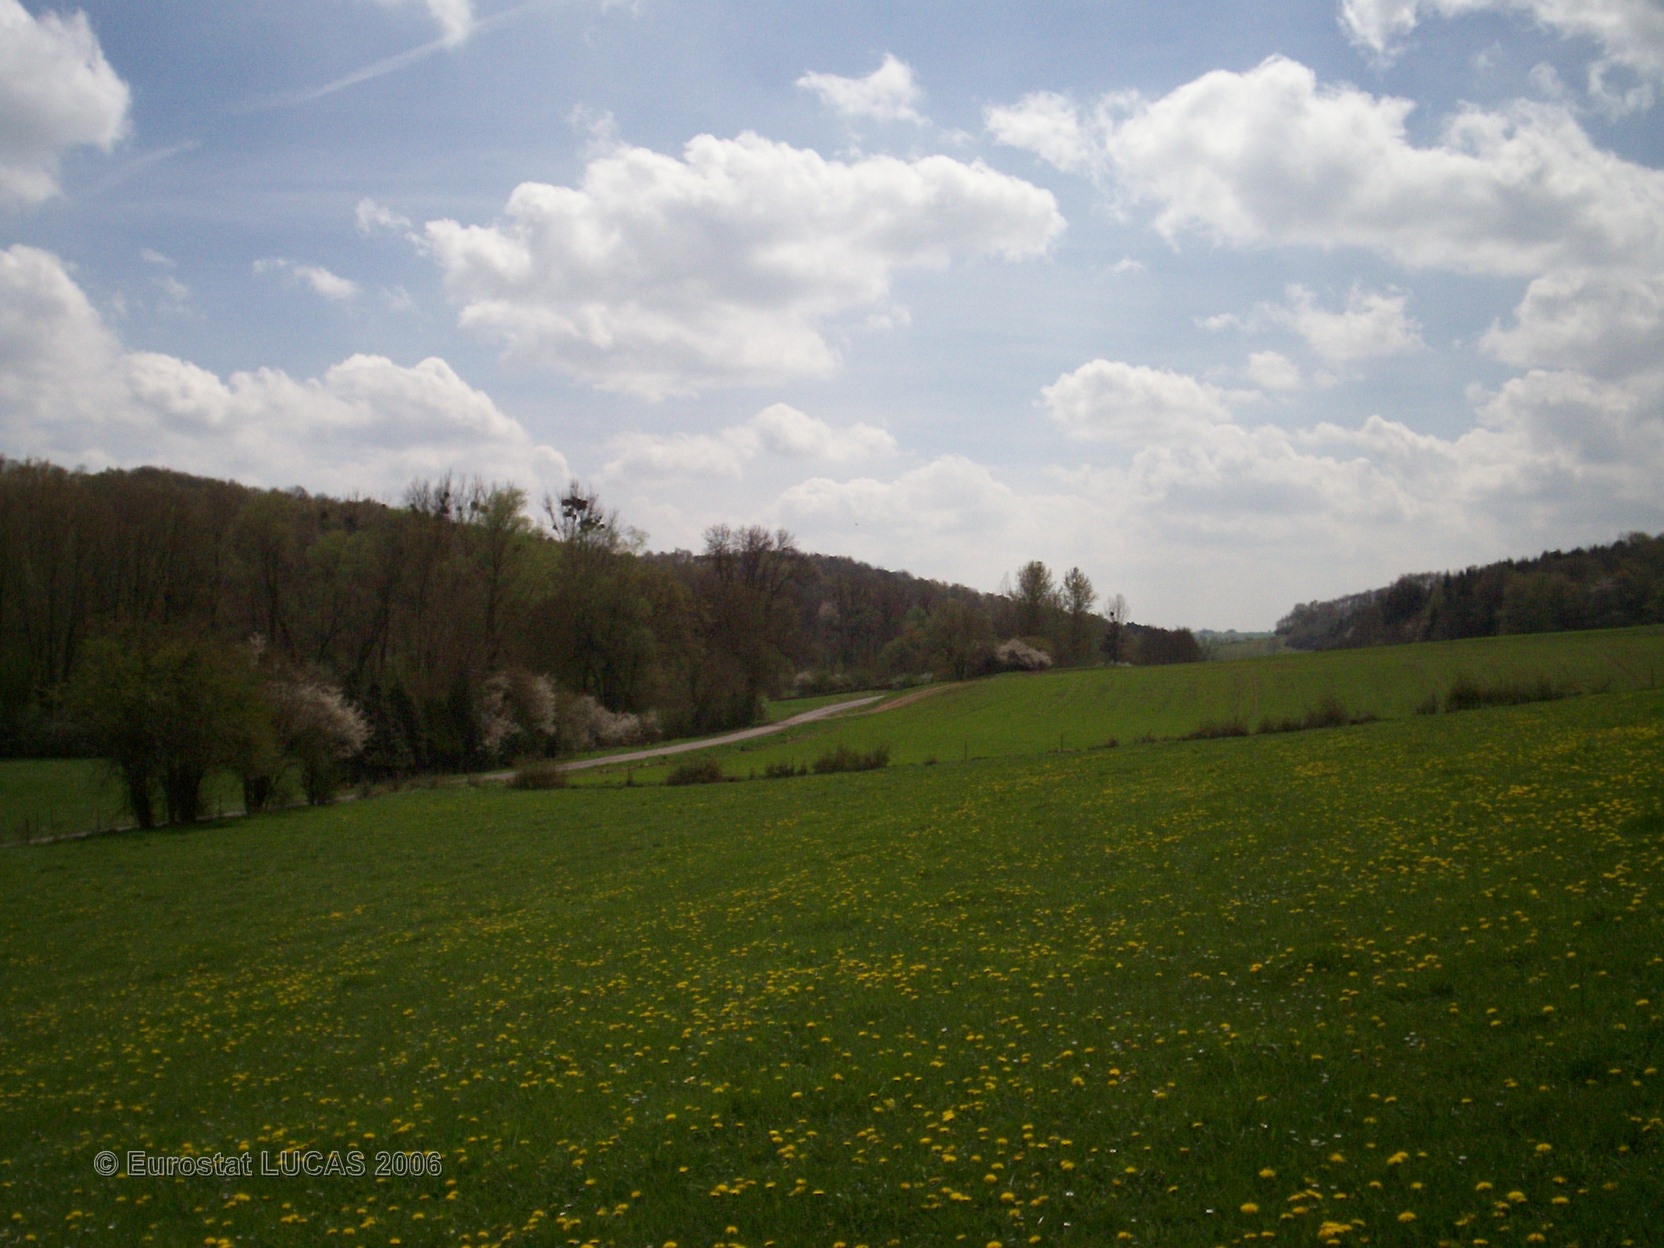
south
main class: Grassland
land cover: Grassland without tree/shrub cover
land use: Agriculture (excluding fallow land and kitchen gardens)
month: May
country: FR
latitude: 49.7942
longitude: 4.3974
